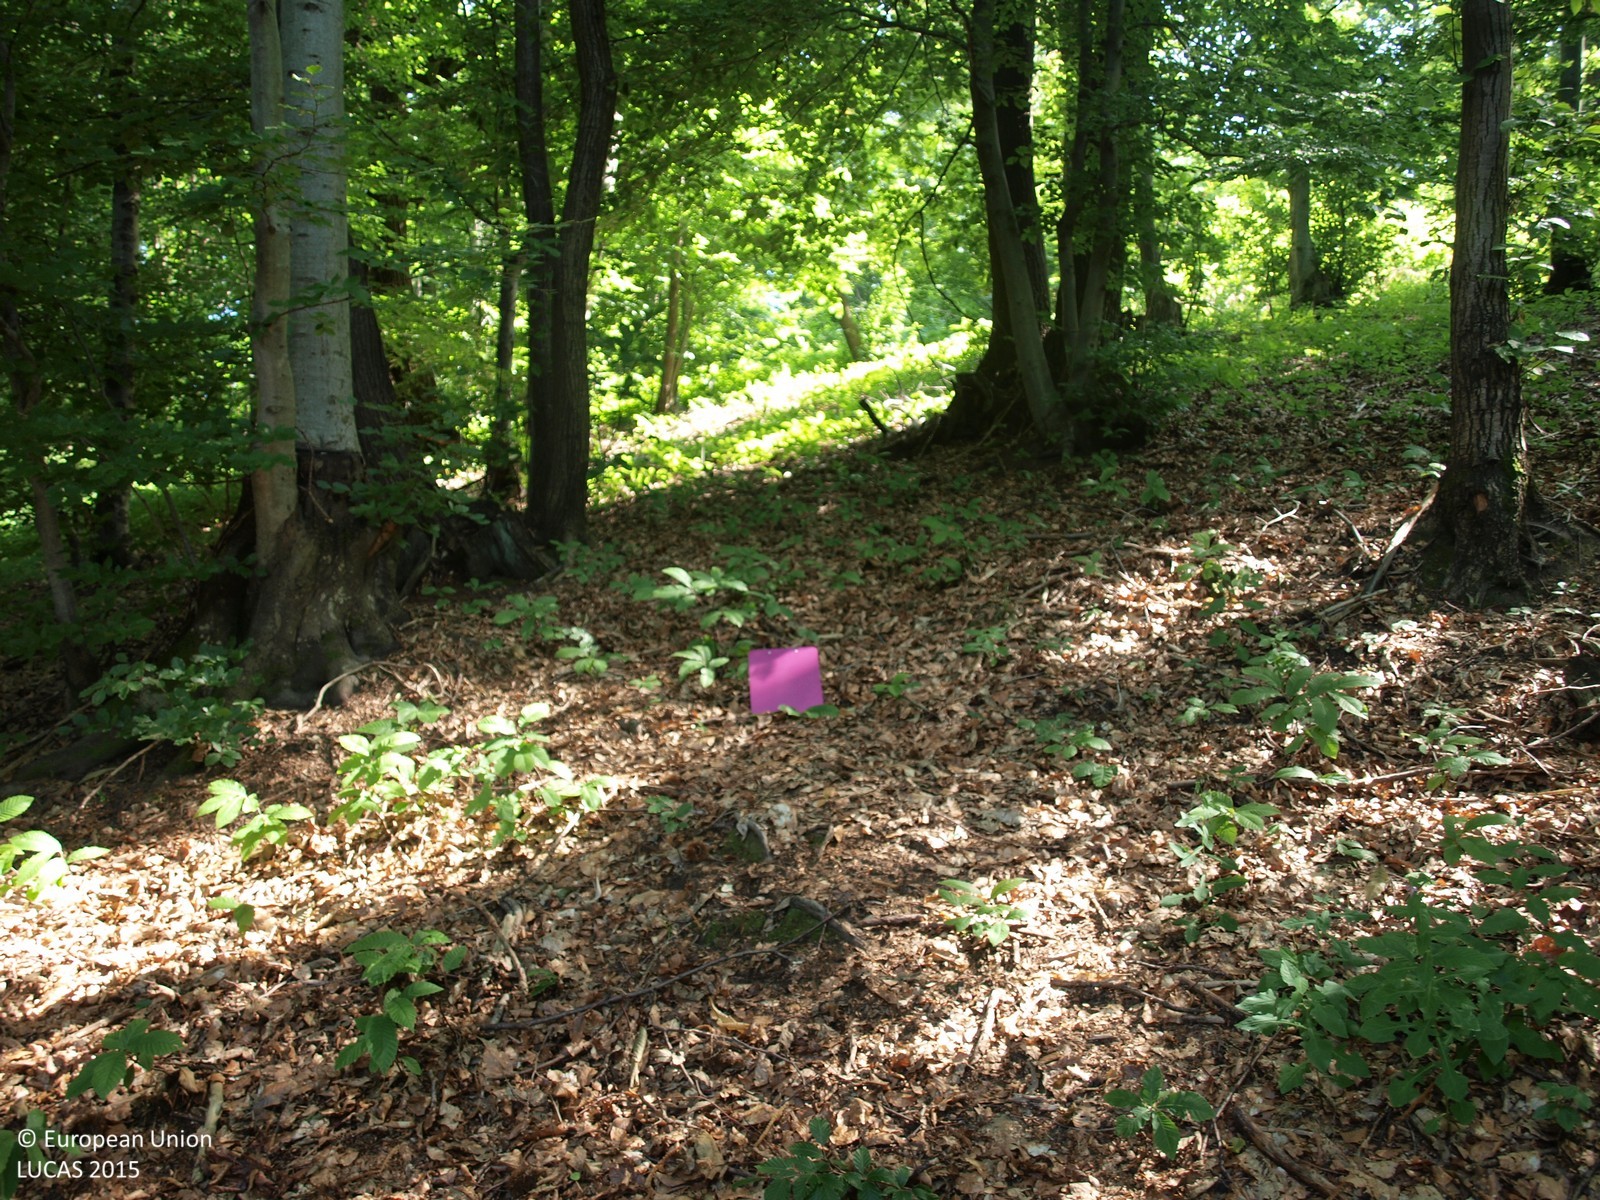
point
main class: Woodland
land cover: Broadleaved woodland
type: mesophytic deciduous forest
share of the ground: > 75 %
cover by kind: broadleaved forest trees 100 %
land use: Forestry
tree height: > 5 m
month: July
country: HR
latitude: 45.7482
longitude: 15.6916
